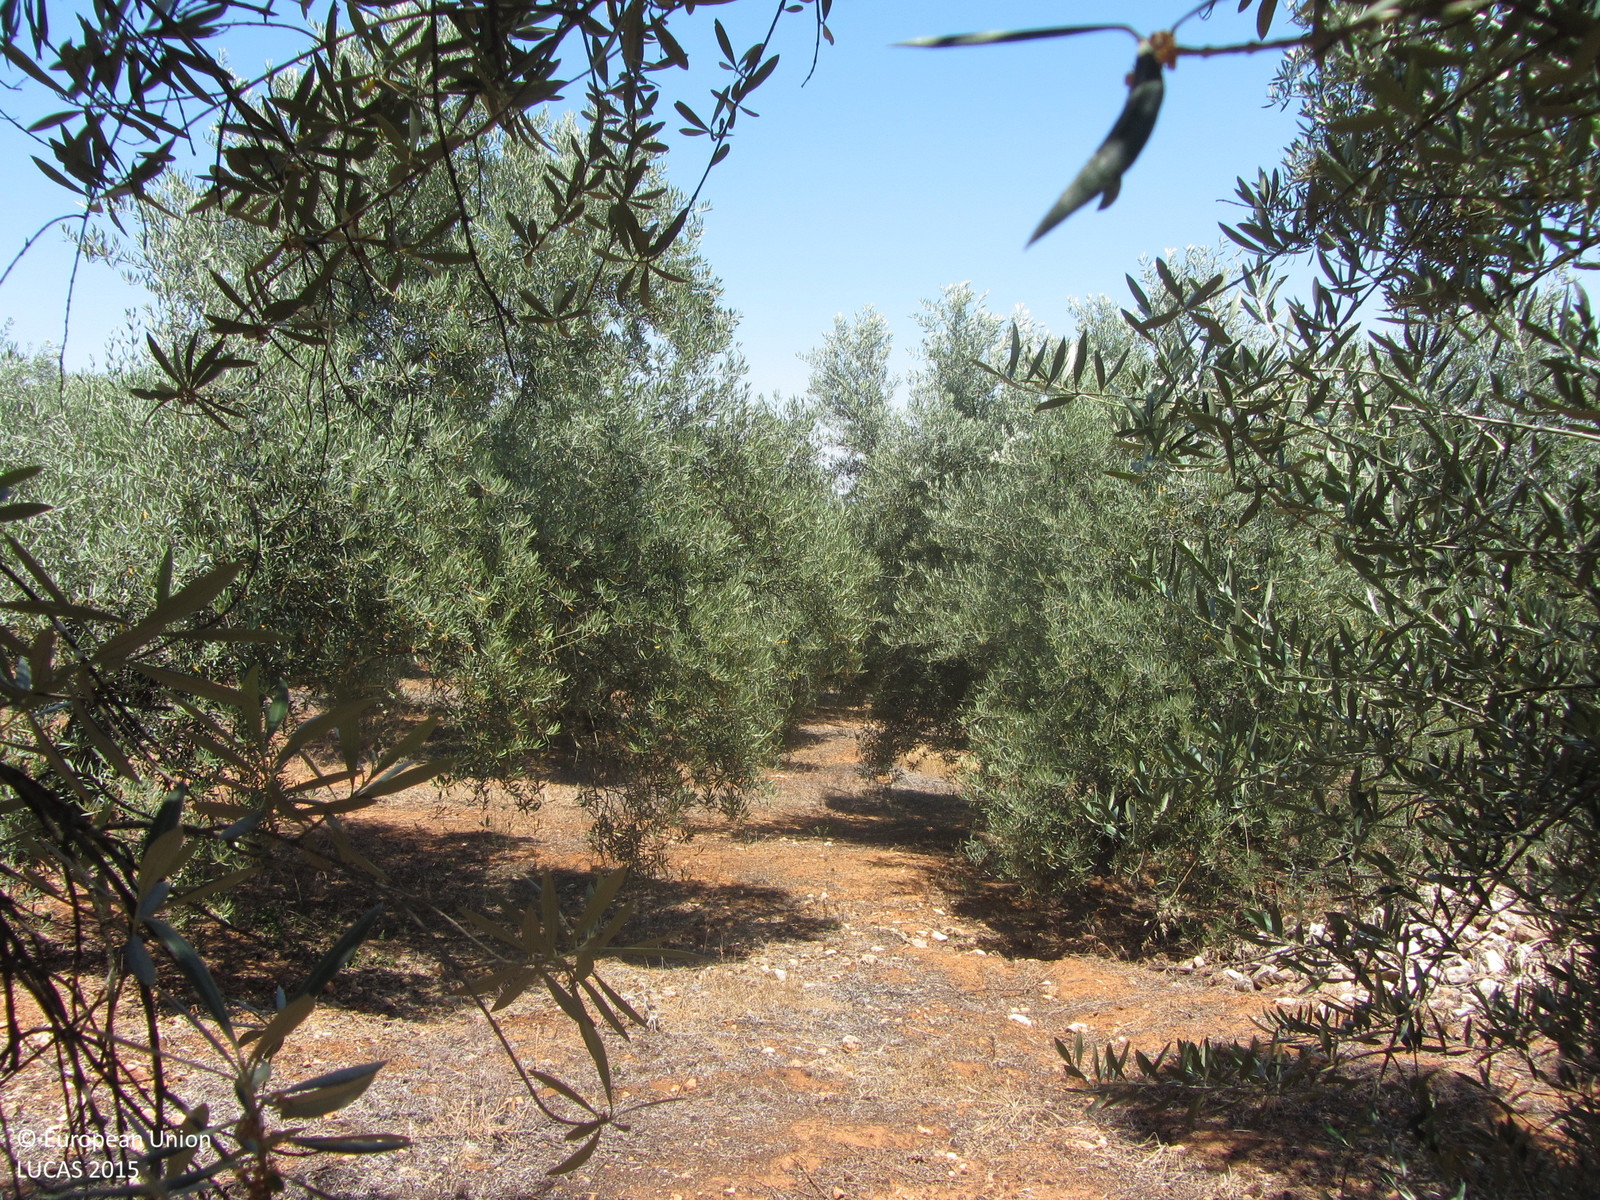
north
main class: Cropland
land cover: Olive groves
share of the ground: 50 - 75 %
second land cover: Other bare soil
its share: > 75 %
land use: Agriculture (excluding fallow land and kitchen gardens)
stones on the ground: < 10 %
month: June
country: ES
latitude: 38.2789
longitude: -2.8825
